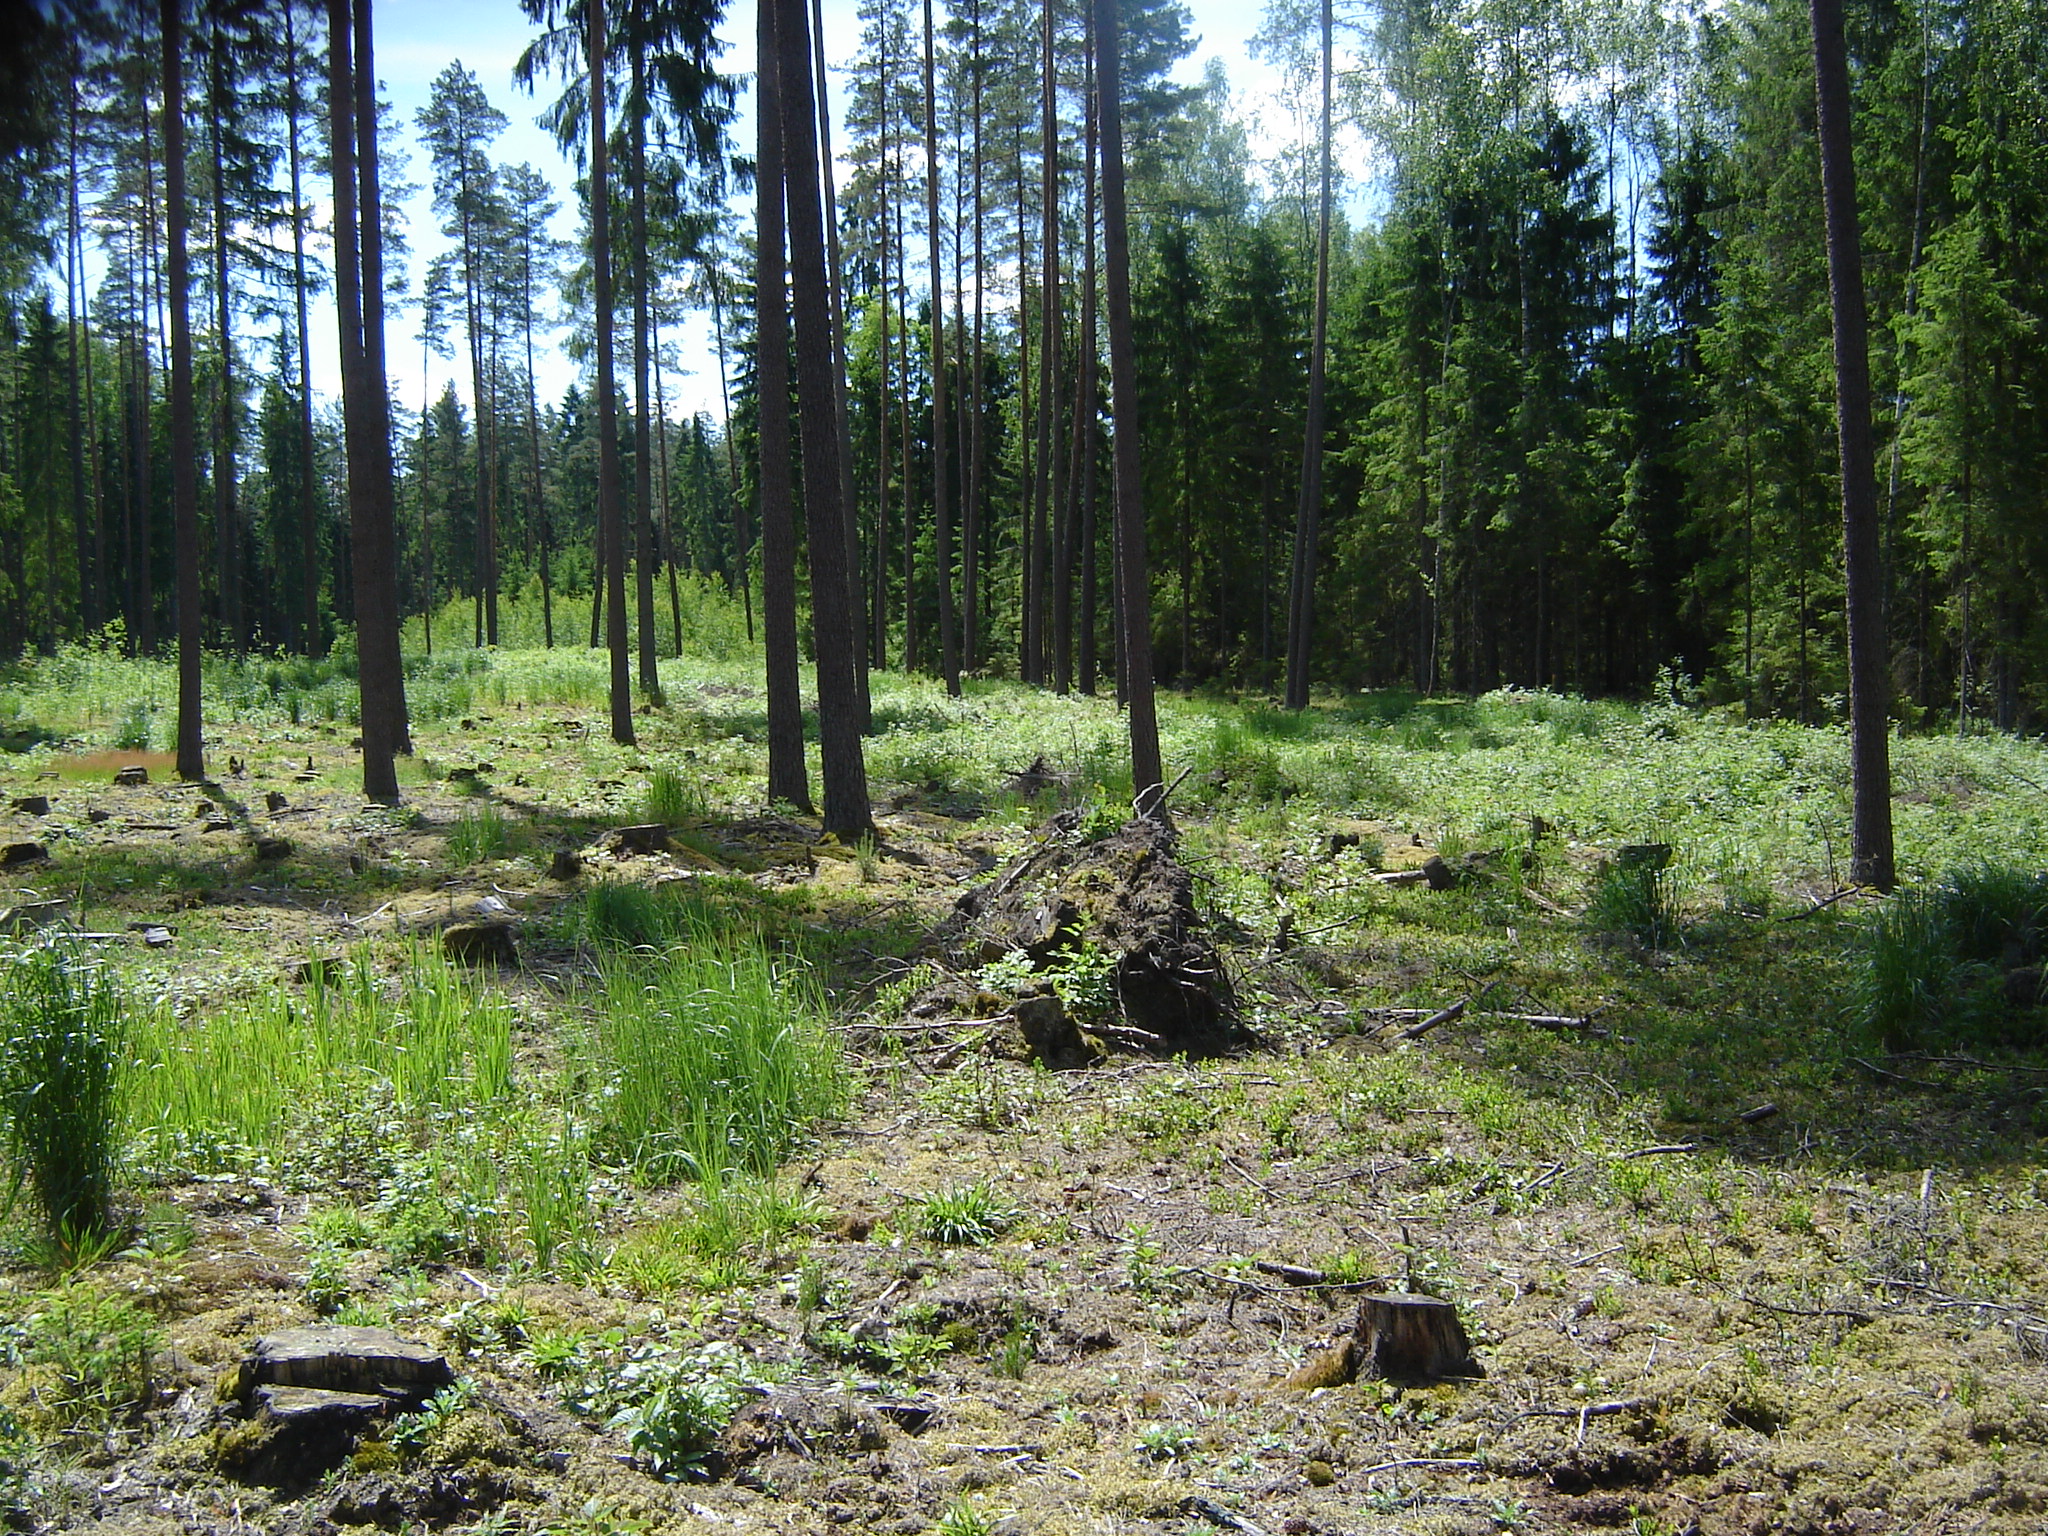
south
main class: Woodland
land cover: Pine dominated coniferous woodland
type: hemiboreal forest and nemoral coniferous forest and mixed broadleaved-coniferous forest
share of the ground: 50 - 75 %
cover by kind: coniferous forest trees 50 %, lichens and mosses 30 %, shrubs 10 %, herbaceous plants 10 %
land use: Forestry
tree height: > 5 m
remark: Clear cut
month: June
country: LT
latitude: 55.6807
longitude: 25.1763
